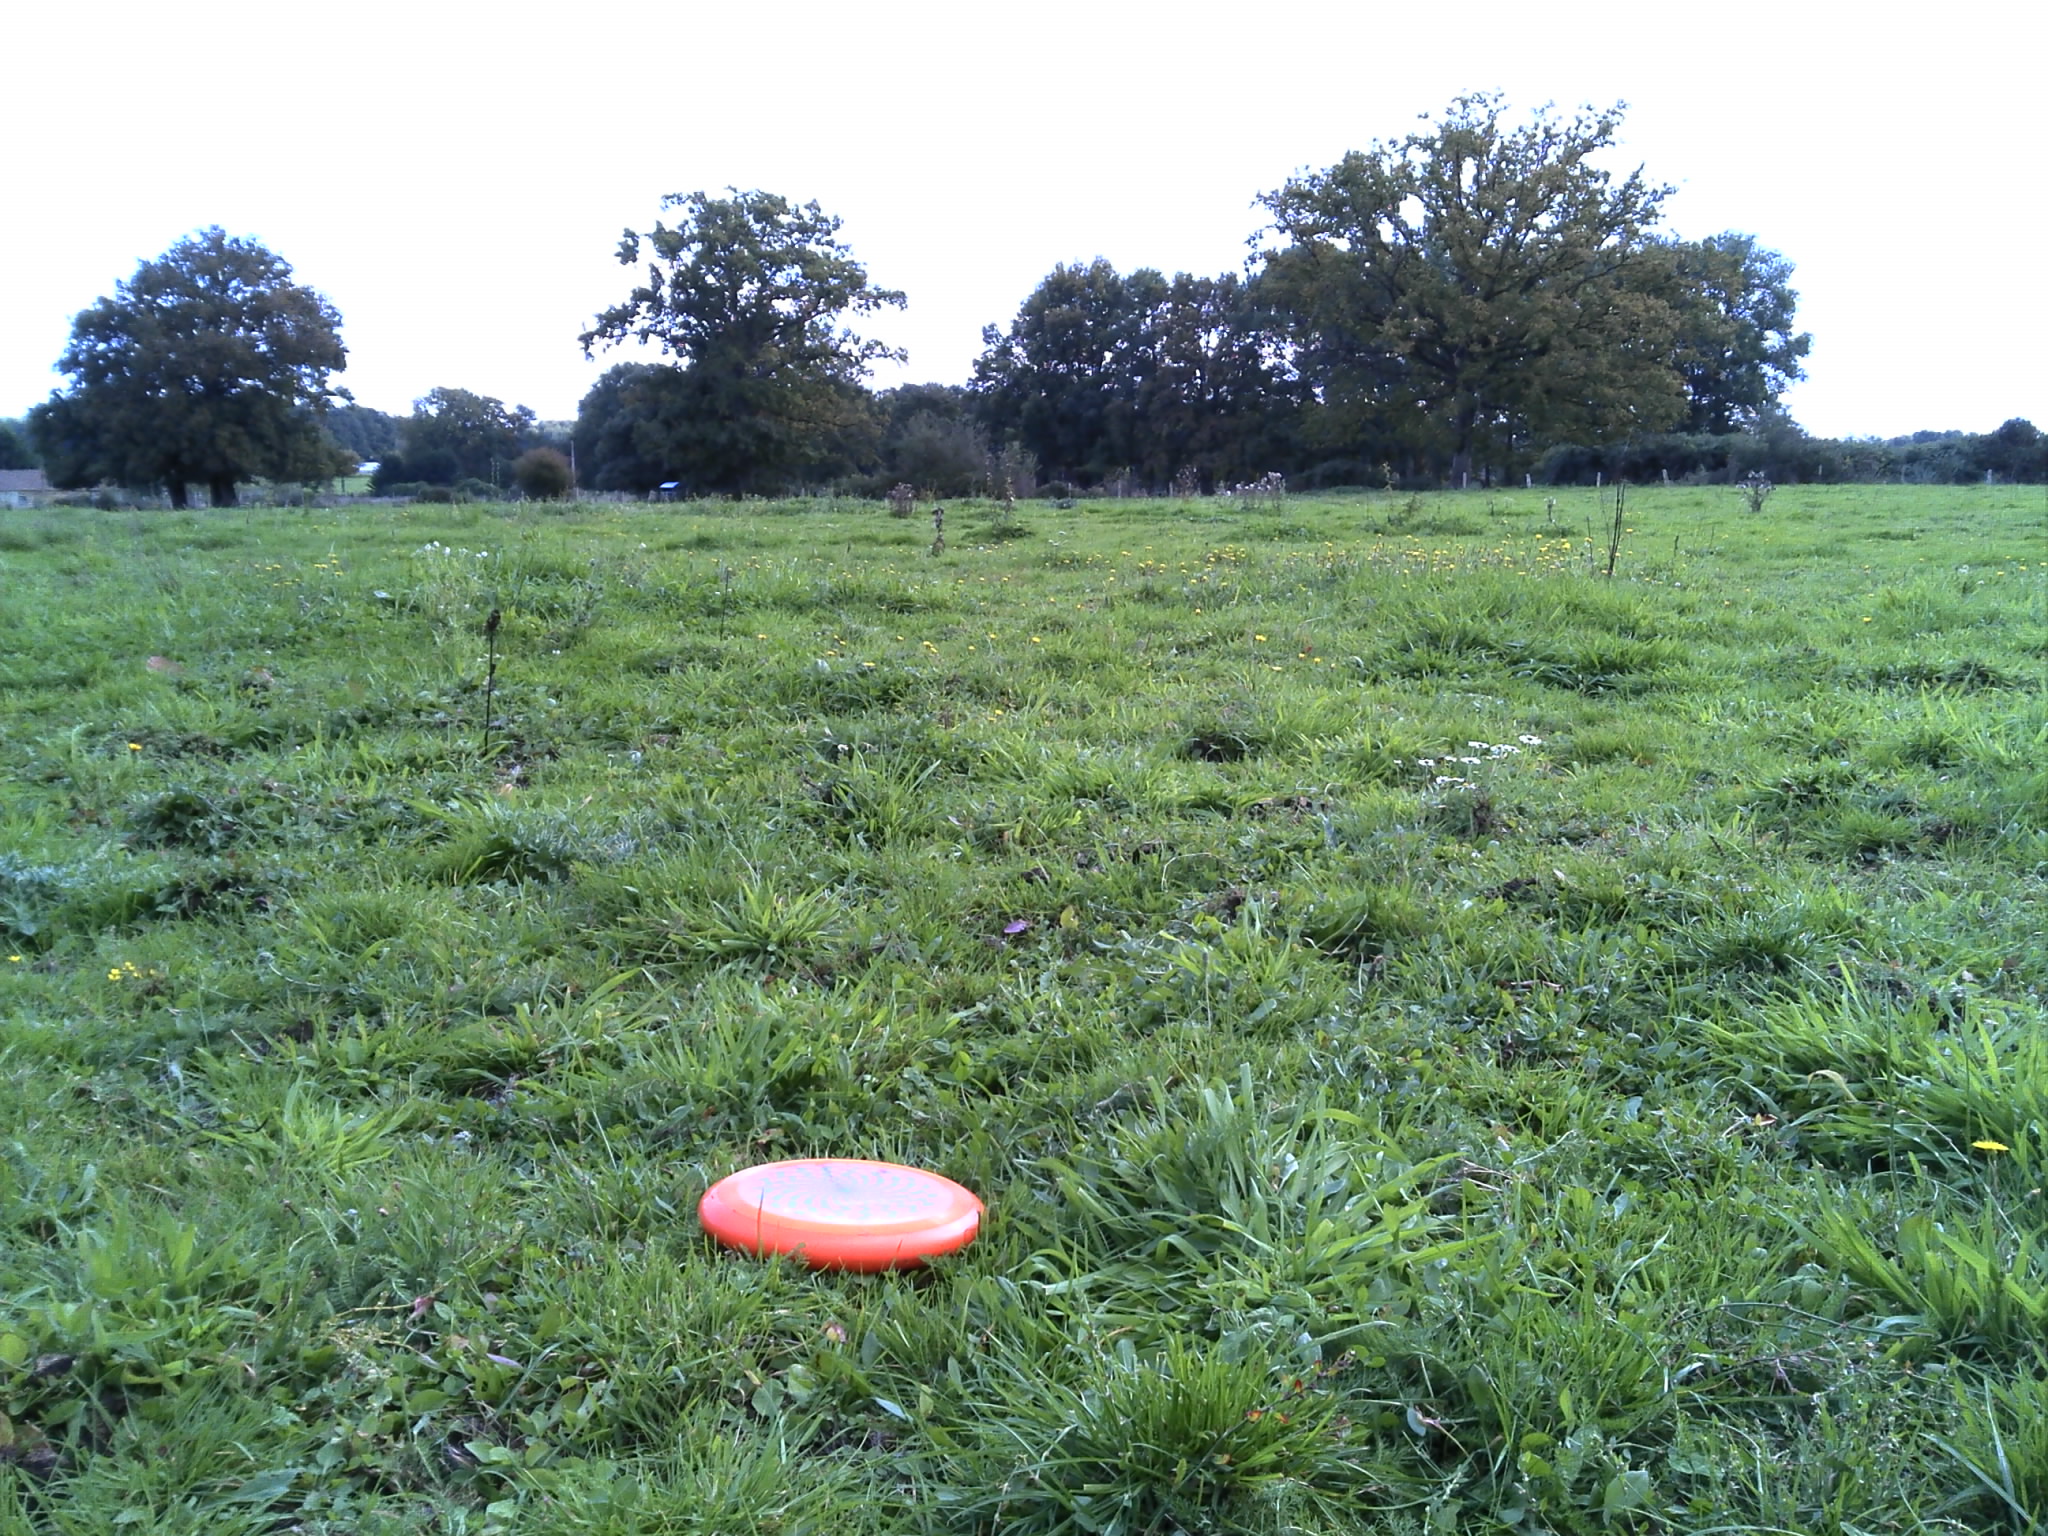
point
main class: Grassland
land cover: Grassland without tree/shrub cover
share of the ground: > 75 %
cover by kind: herbaceous plants 100 %
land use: Agriculture (excluding fallow land and kitchen gardens)
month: October
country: FR
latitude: 47.8265
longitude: 0.0482
